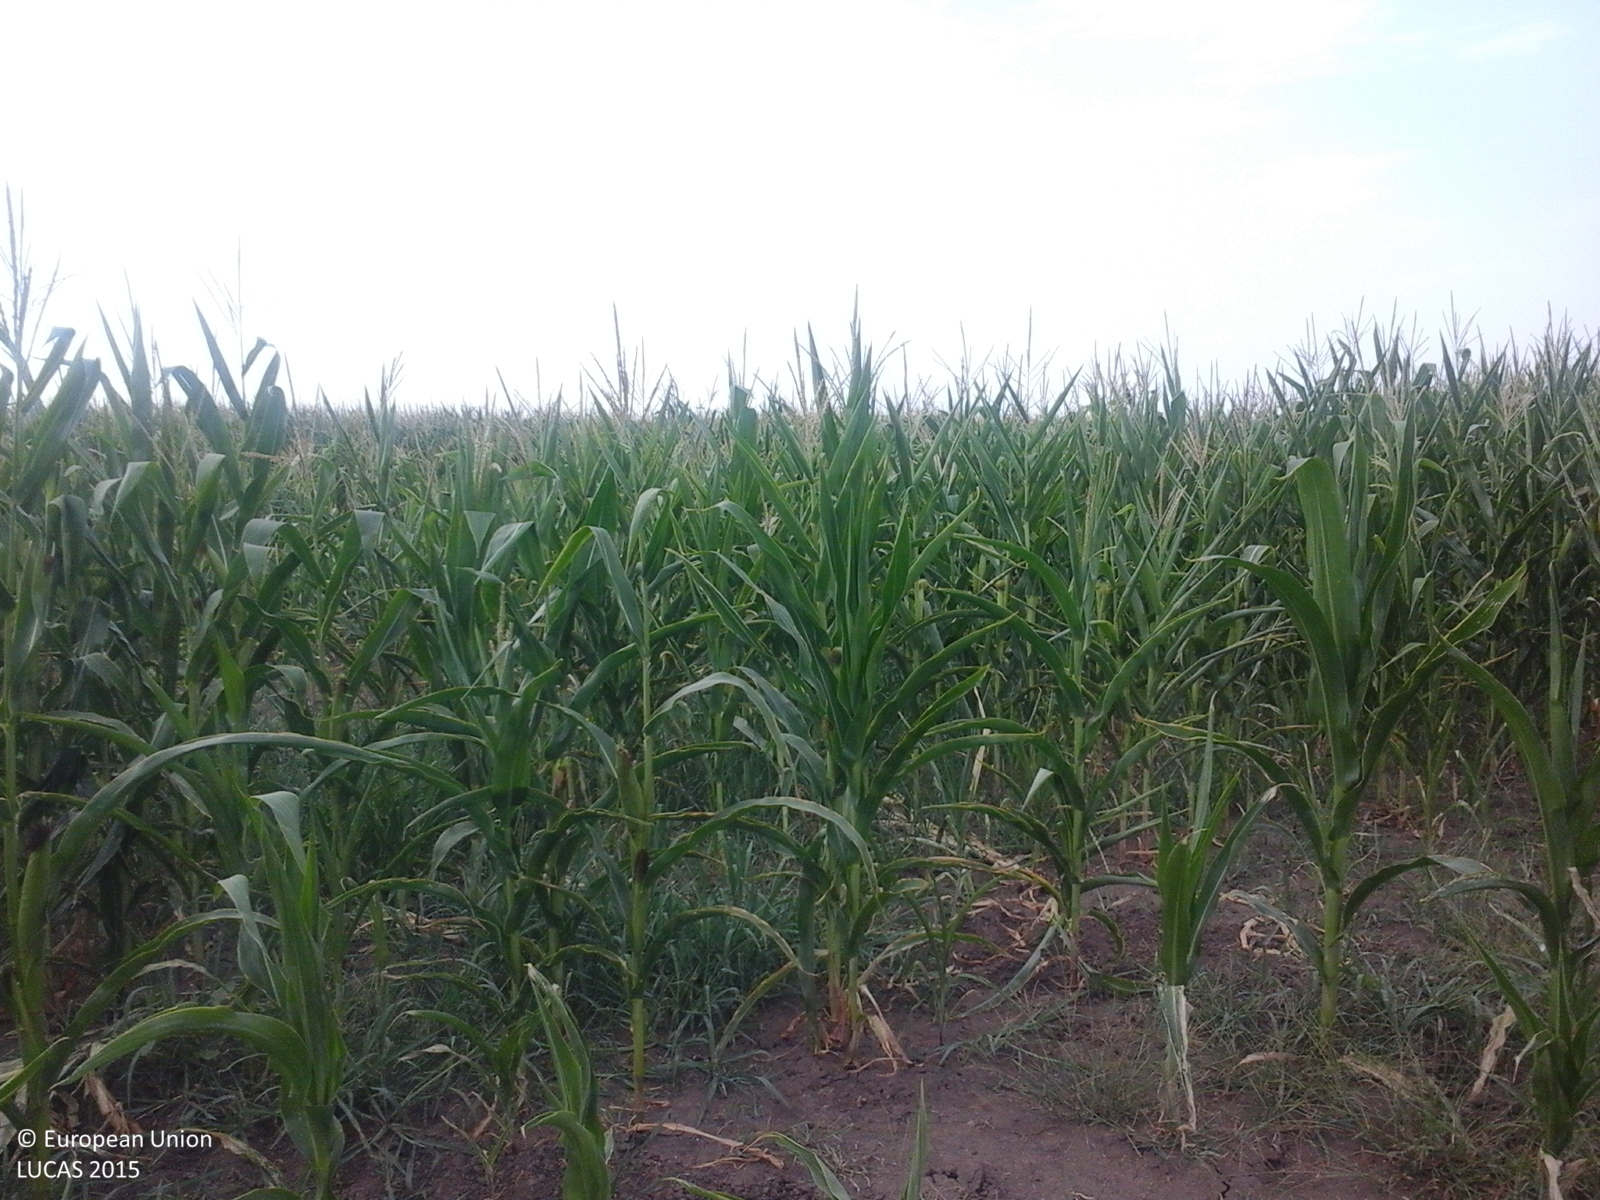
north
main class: Cropland
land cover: Maize
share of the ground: > 75 %
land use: Agriculture (excluding fallow land and kitchen gardens)
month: August
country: RO
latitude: 45.0575
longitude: 27.4035
